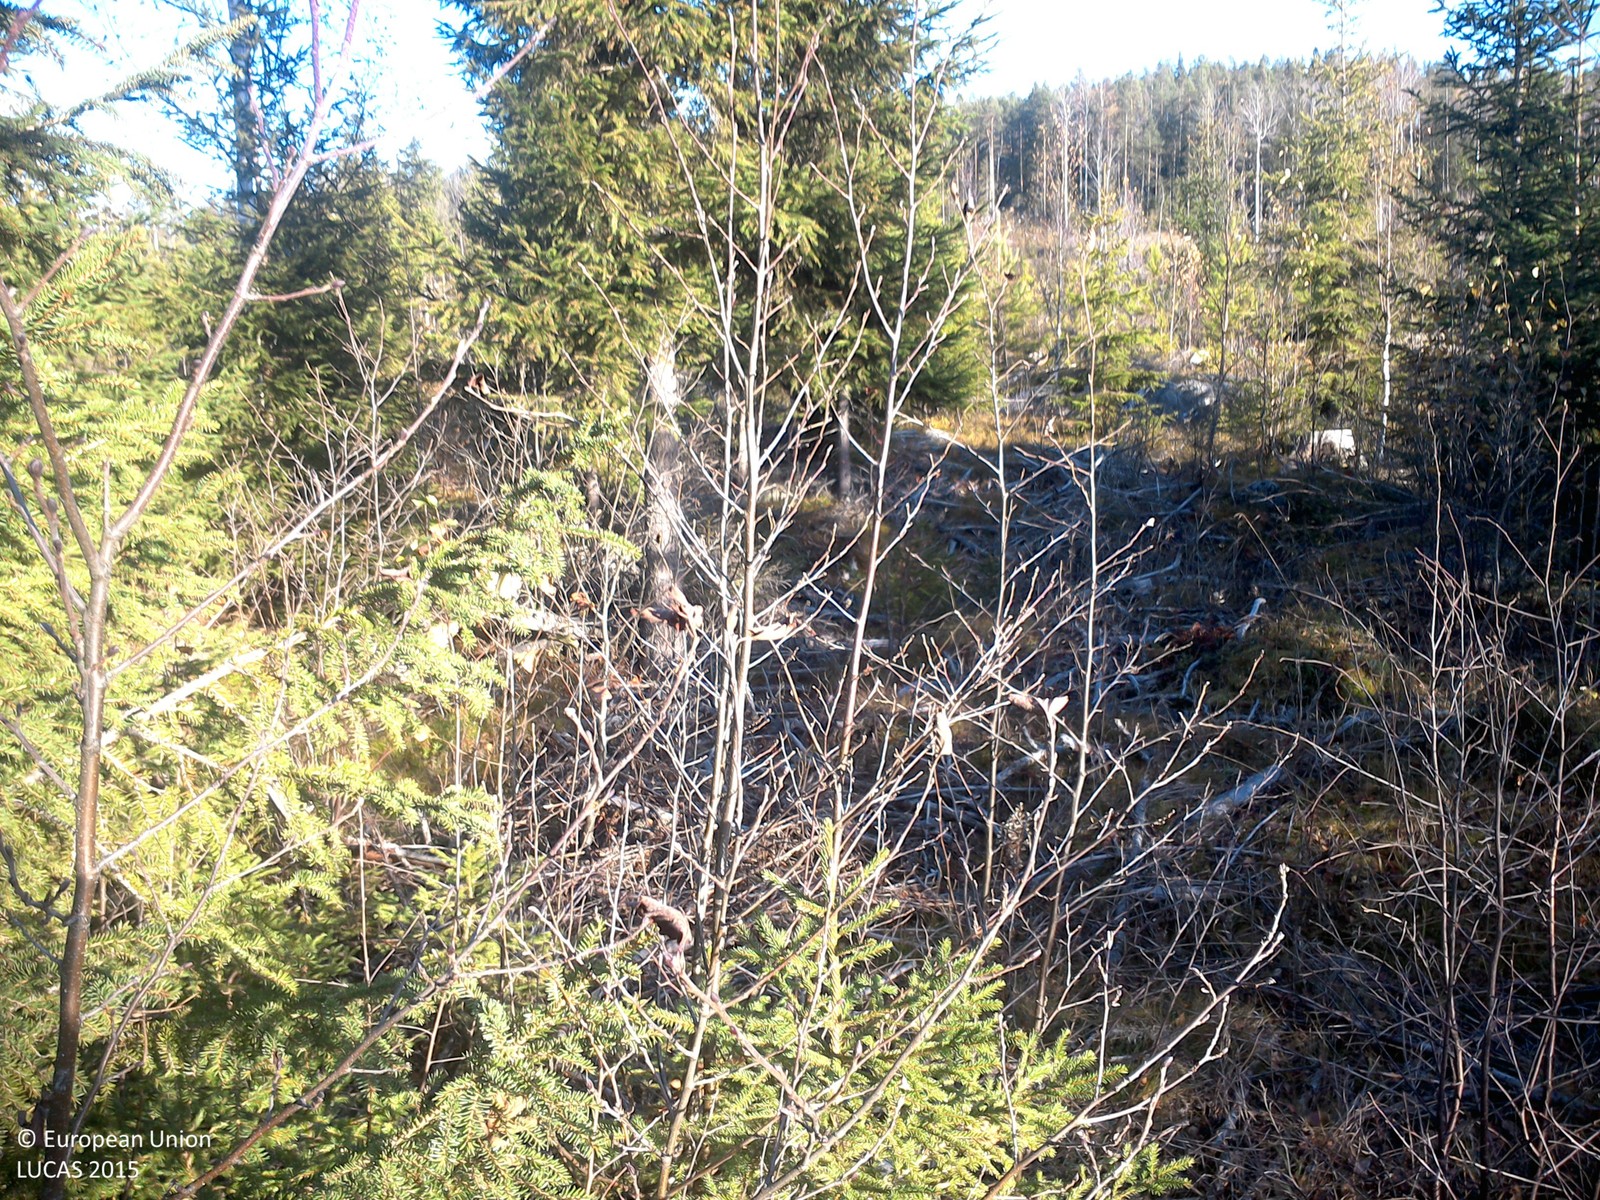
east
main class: Woodland
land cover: Spruce dominated mixed woodland
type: boreal forest
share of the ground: 25 - 50 %
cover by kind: shrubs 50 %, coniferous forest trees 30 %, broadleaved forest trees 20 %
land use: Forestry
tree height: > 5 m
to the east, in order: Spruce dominated mixed woodland; Grassland with sparse tree/shrub cover; Spruce dominated mixed woodland; Pine dominated coniferous woodland
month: October
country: SE
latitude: 63.8852
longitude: 19.6498
